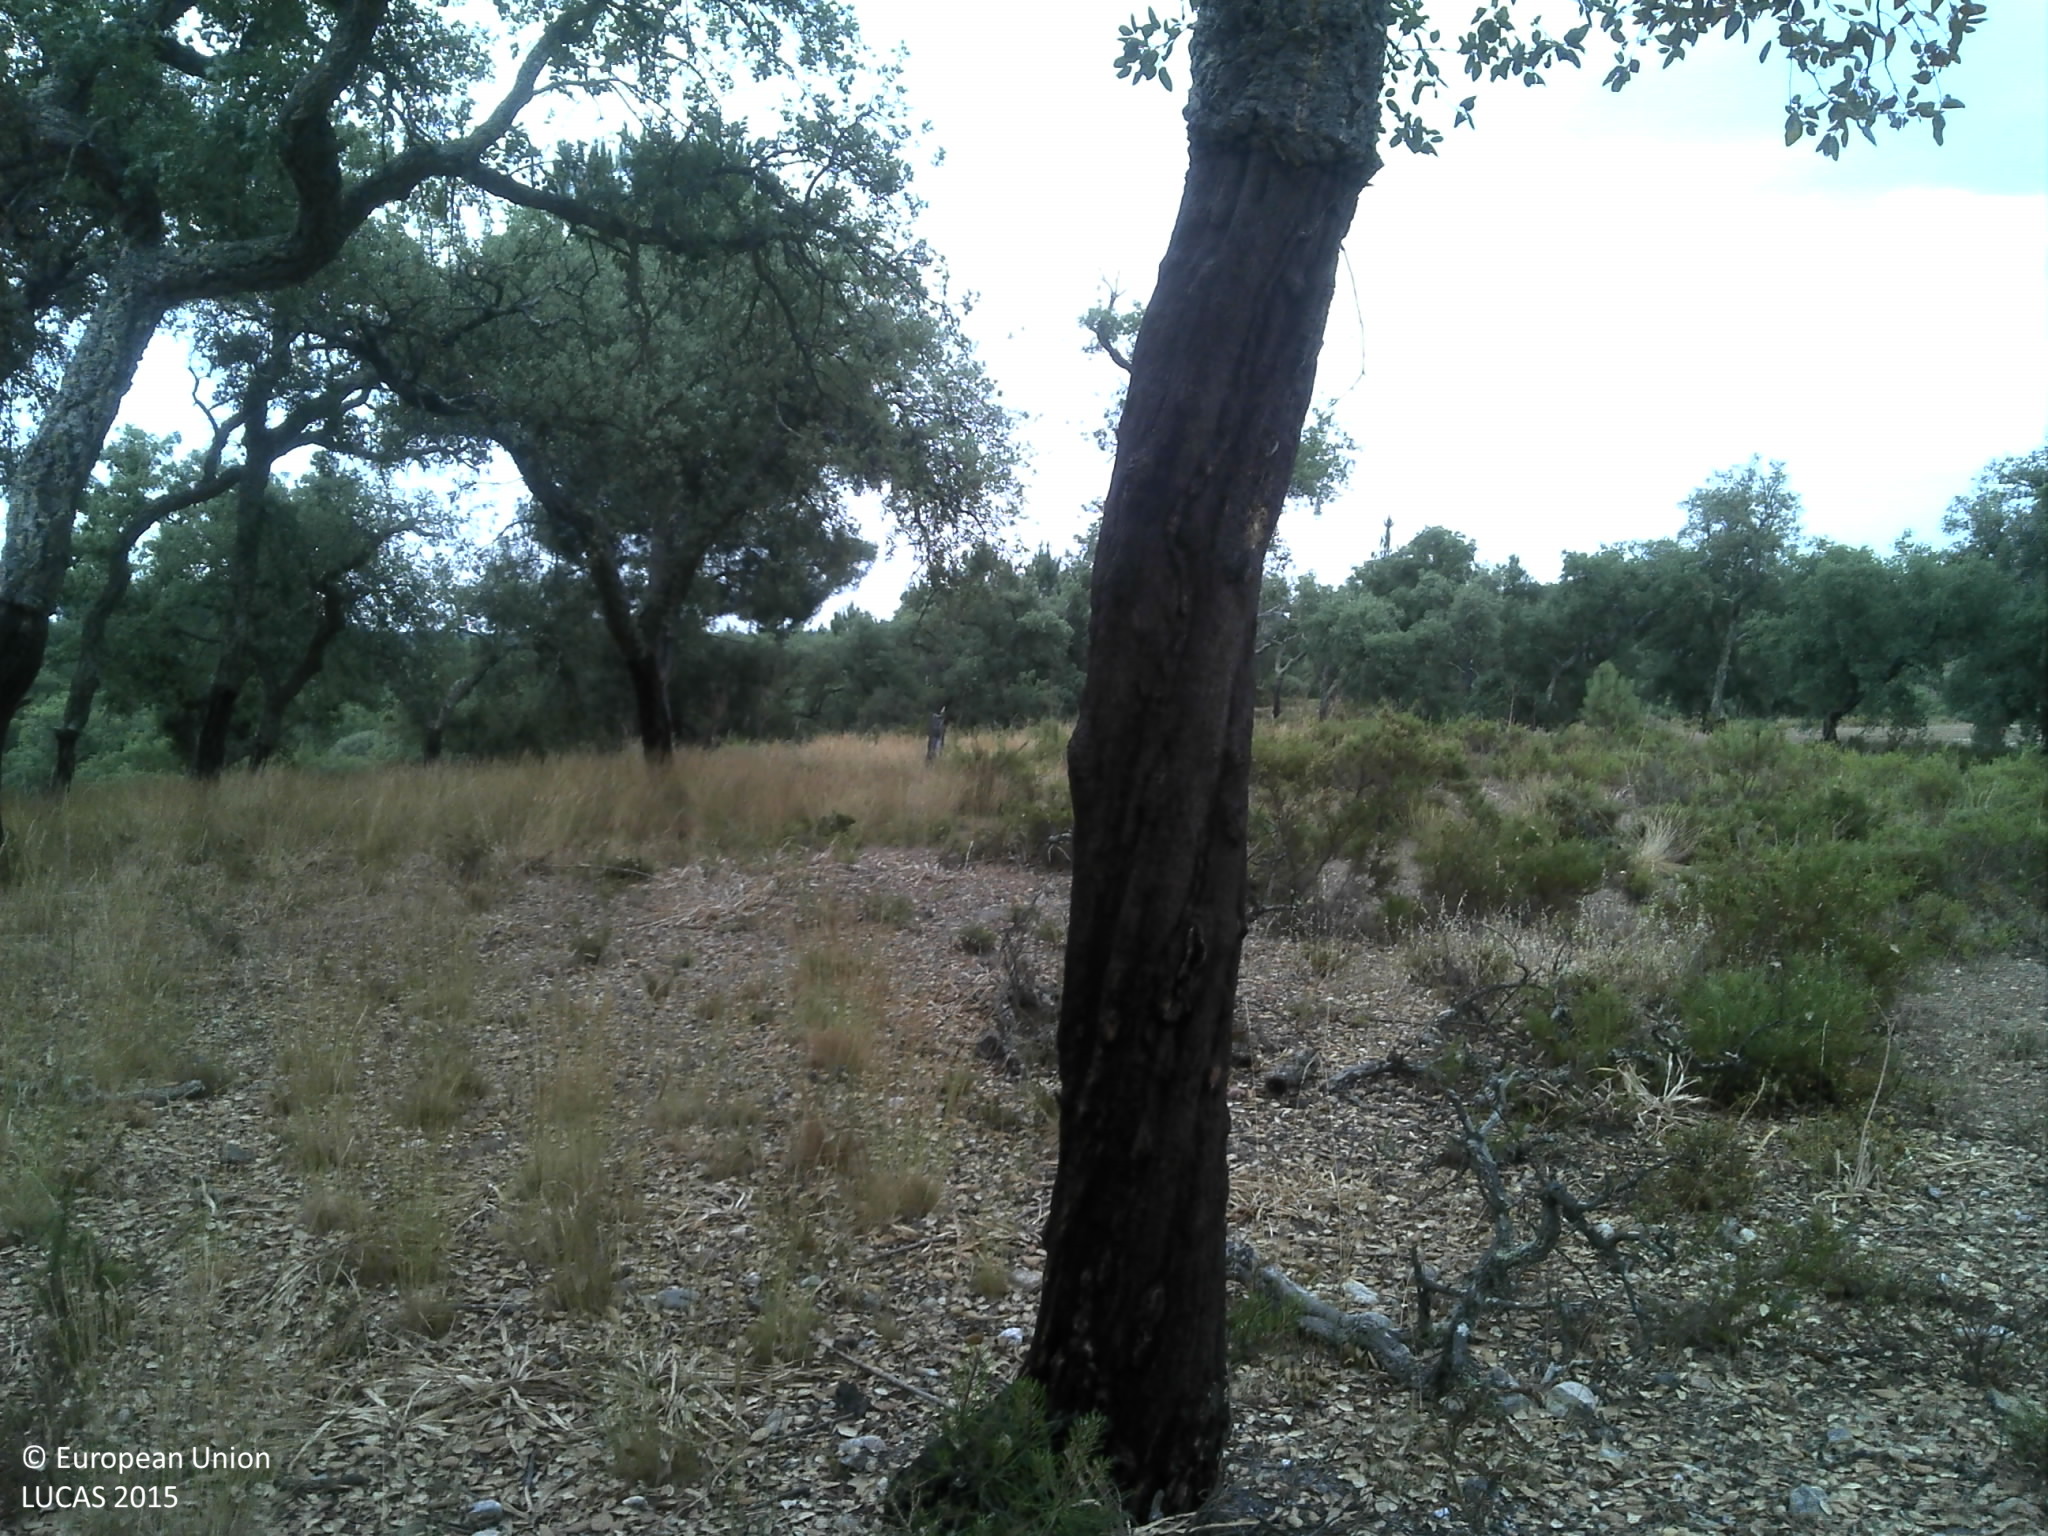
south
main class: Woodland
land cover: Broadleaved woodland
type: broadleaved evergreen forest
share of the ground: 25 - 50 %
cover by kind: broadleaved forest trees 50 %, unconsolidated bare surface 35 %, shrubs 10 %, herbaceous plants 5 %
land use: Forestry
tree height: > 5 m
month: June
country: PT
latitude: 39.3218
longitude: -8.0240
